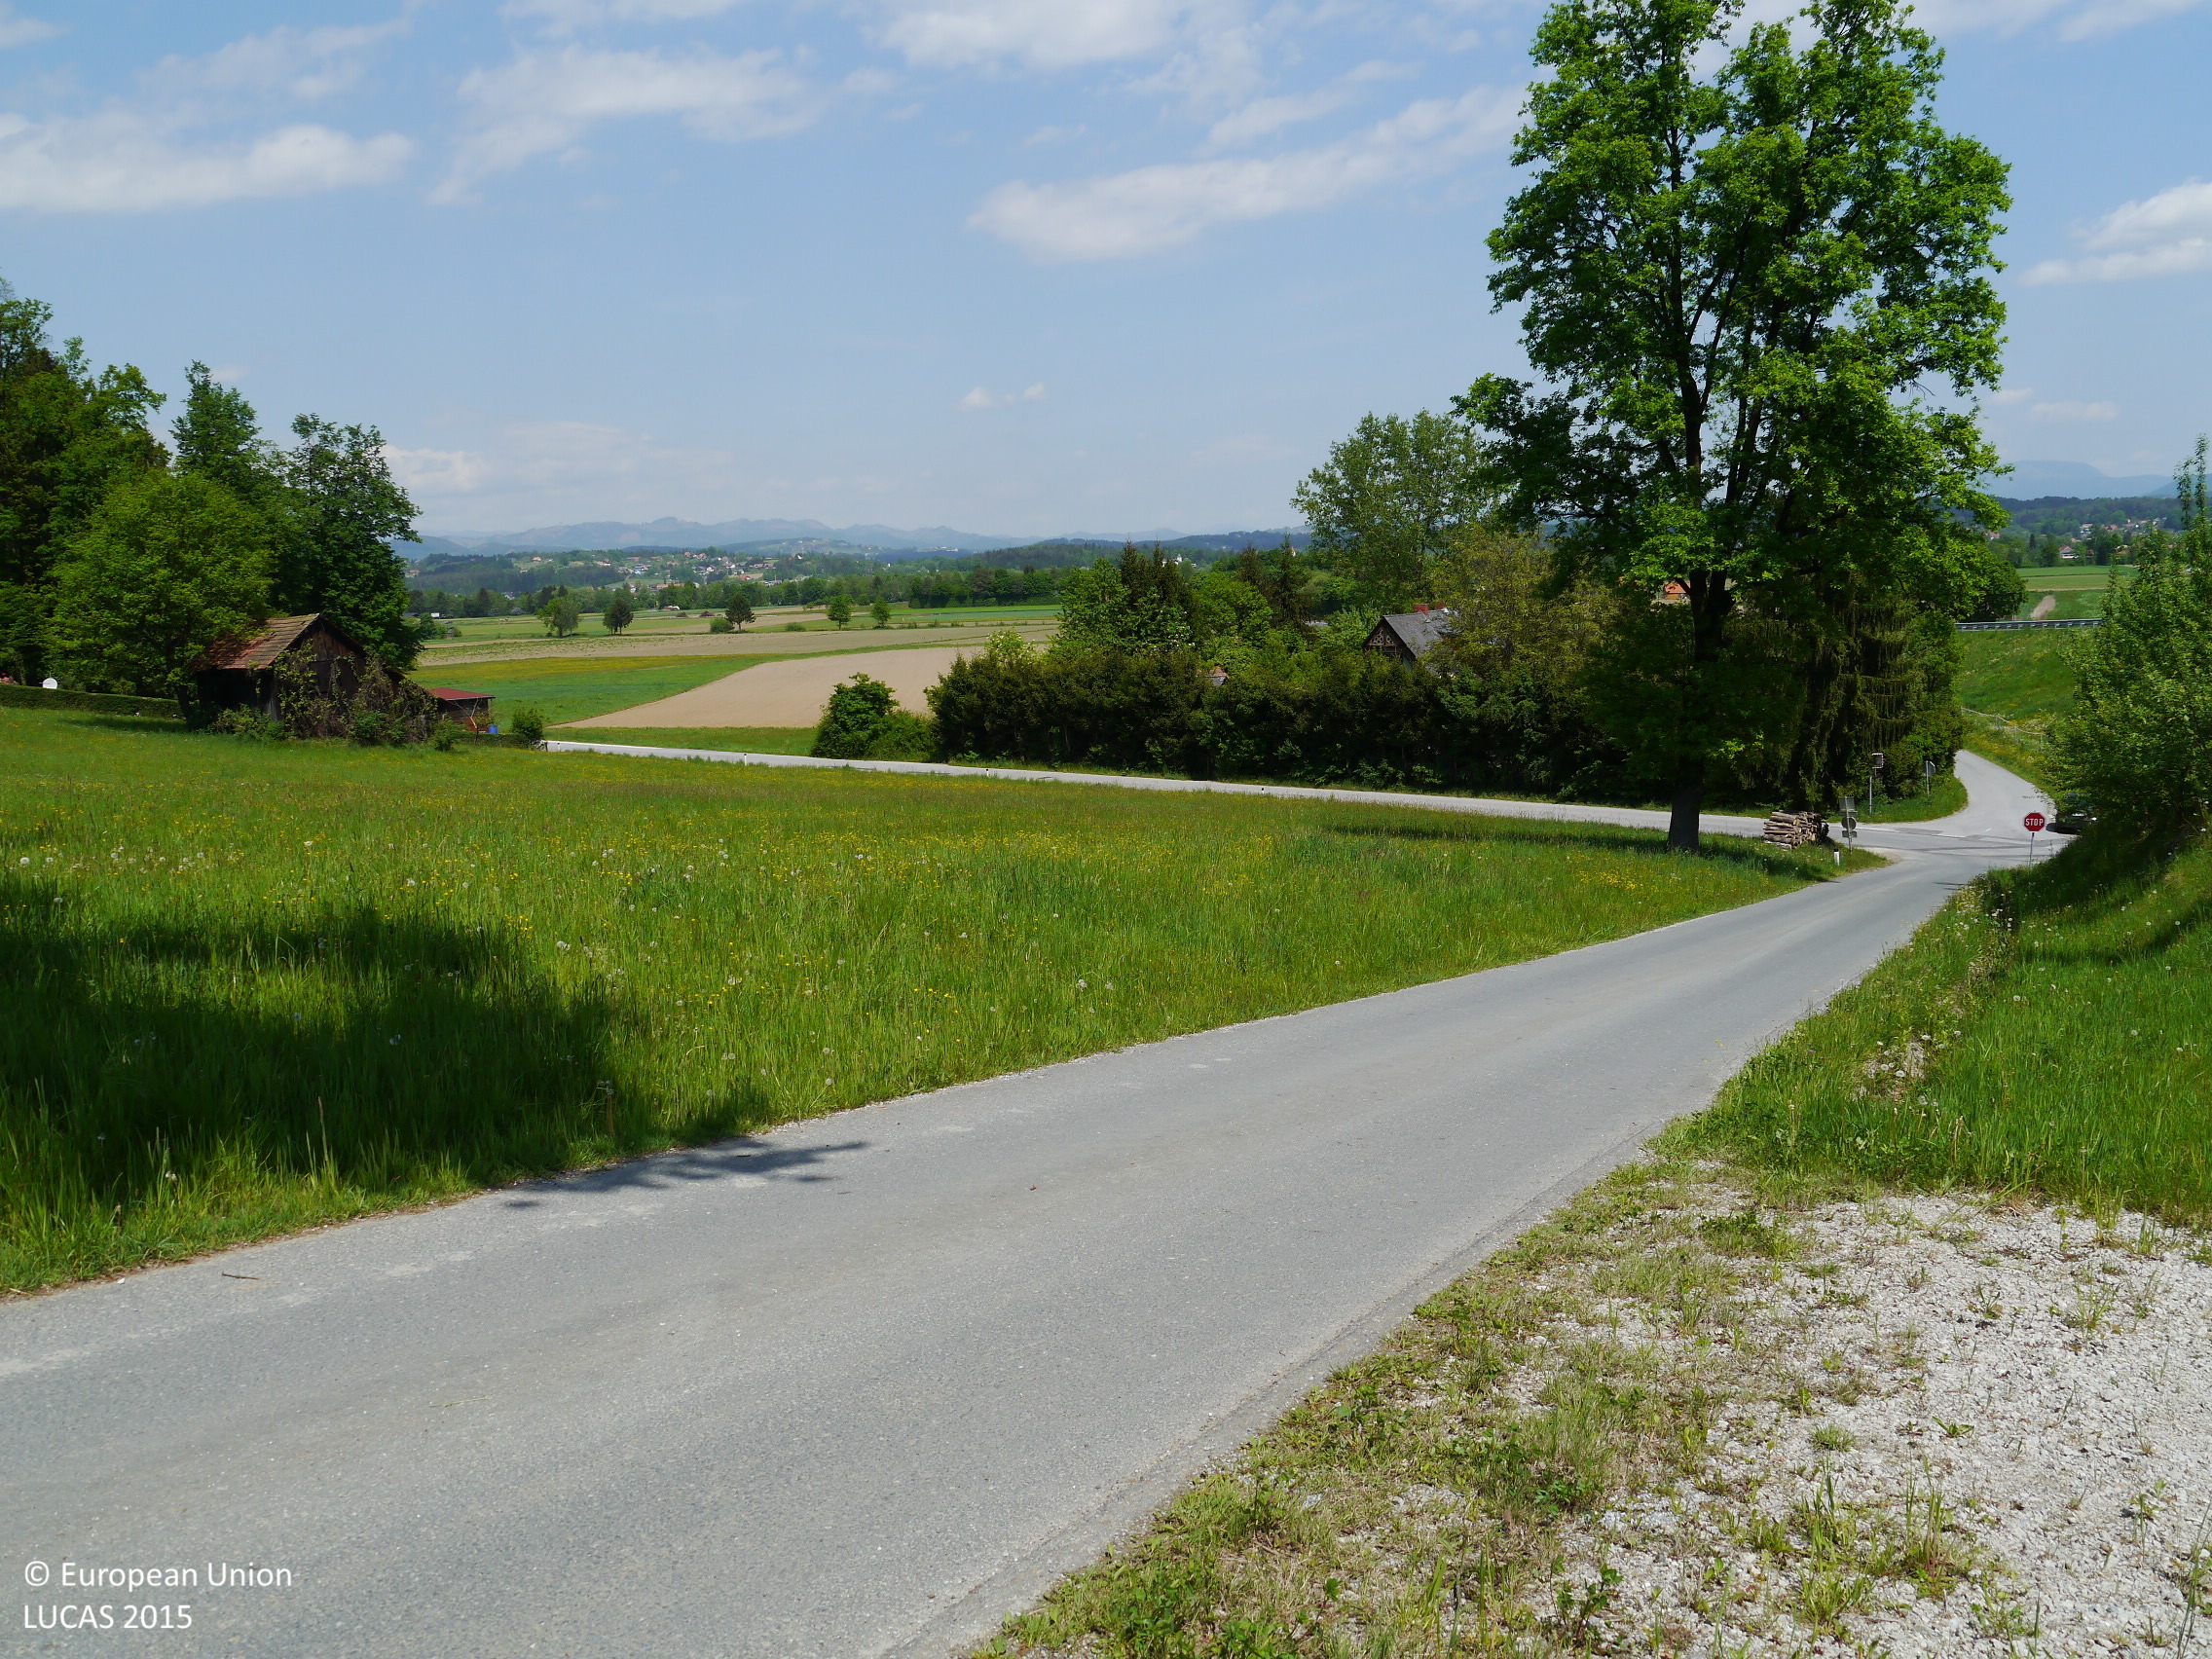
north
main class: Grassland
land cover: Grassland without tree/shrub cover
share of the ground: > 75 %
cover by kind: herbaceous plants 100 %
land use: Road transport
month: May
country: AT
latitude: 46.9792
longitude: 15.2709
